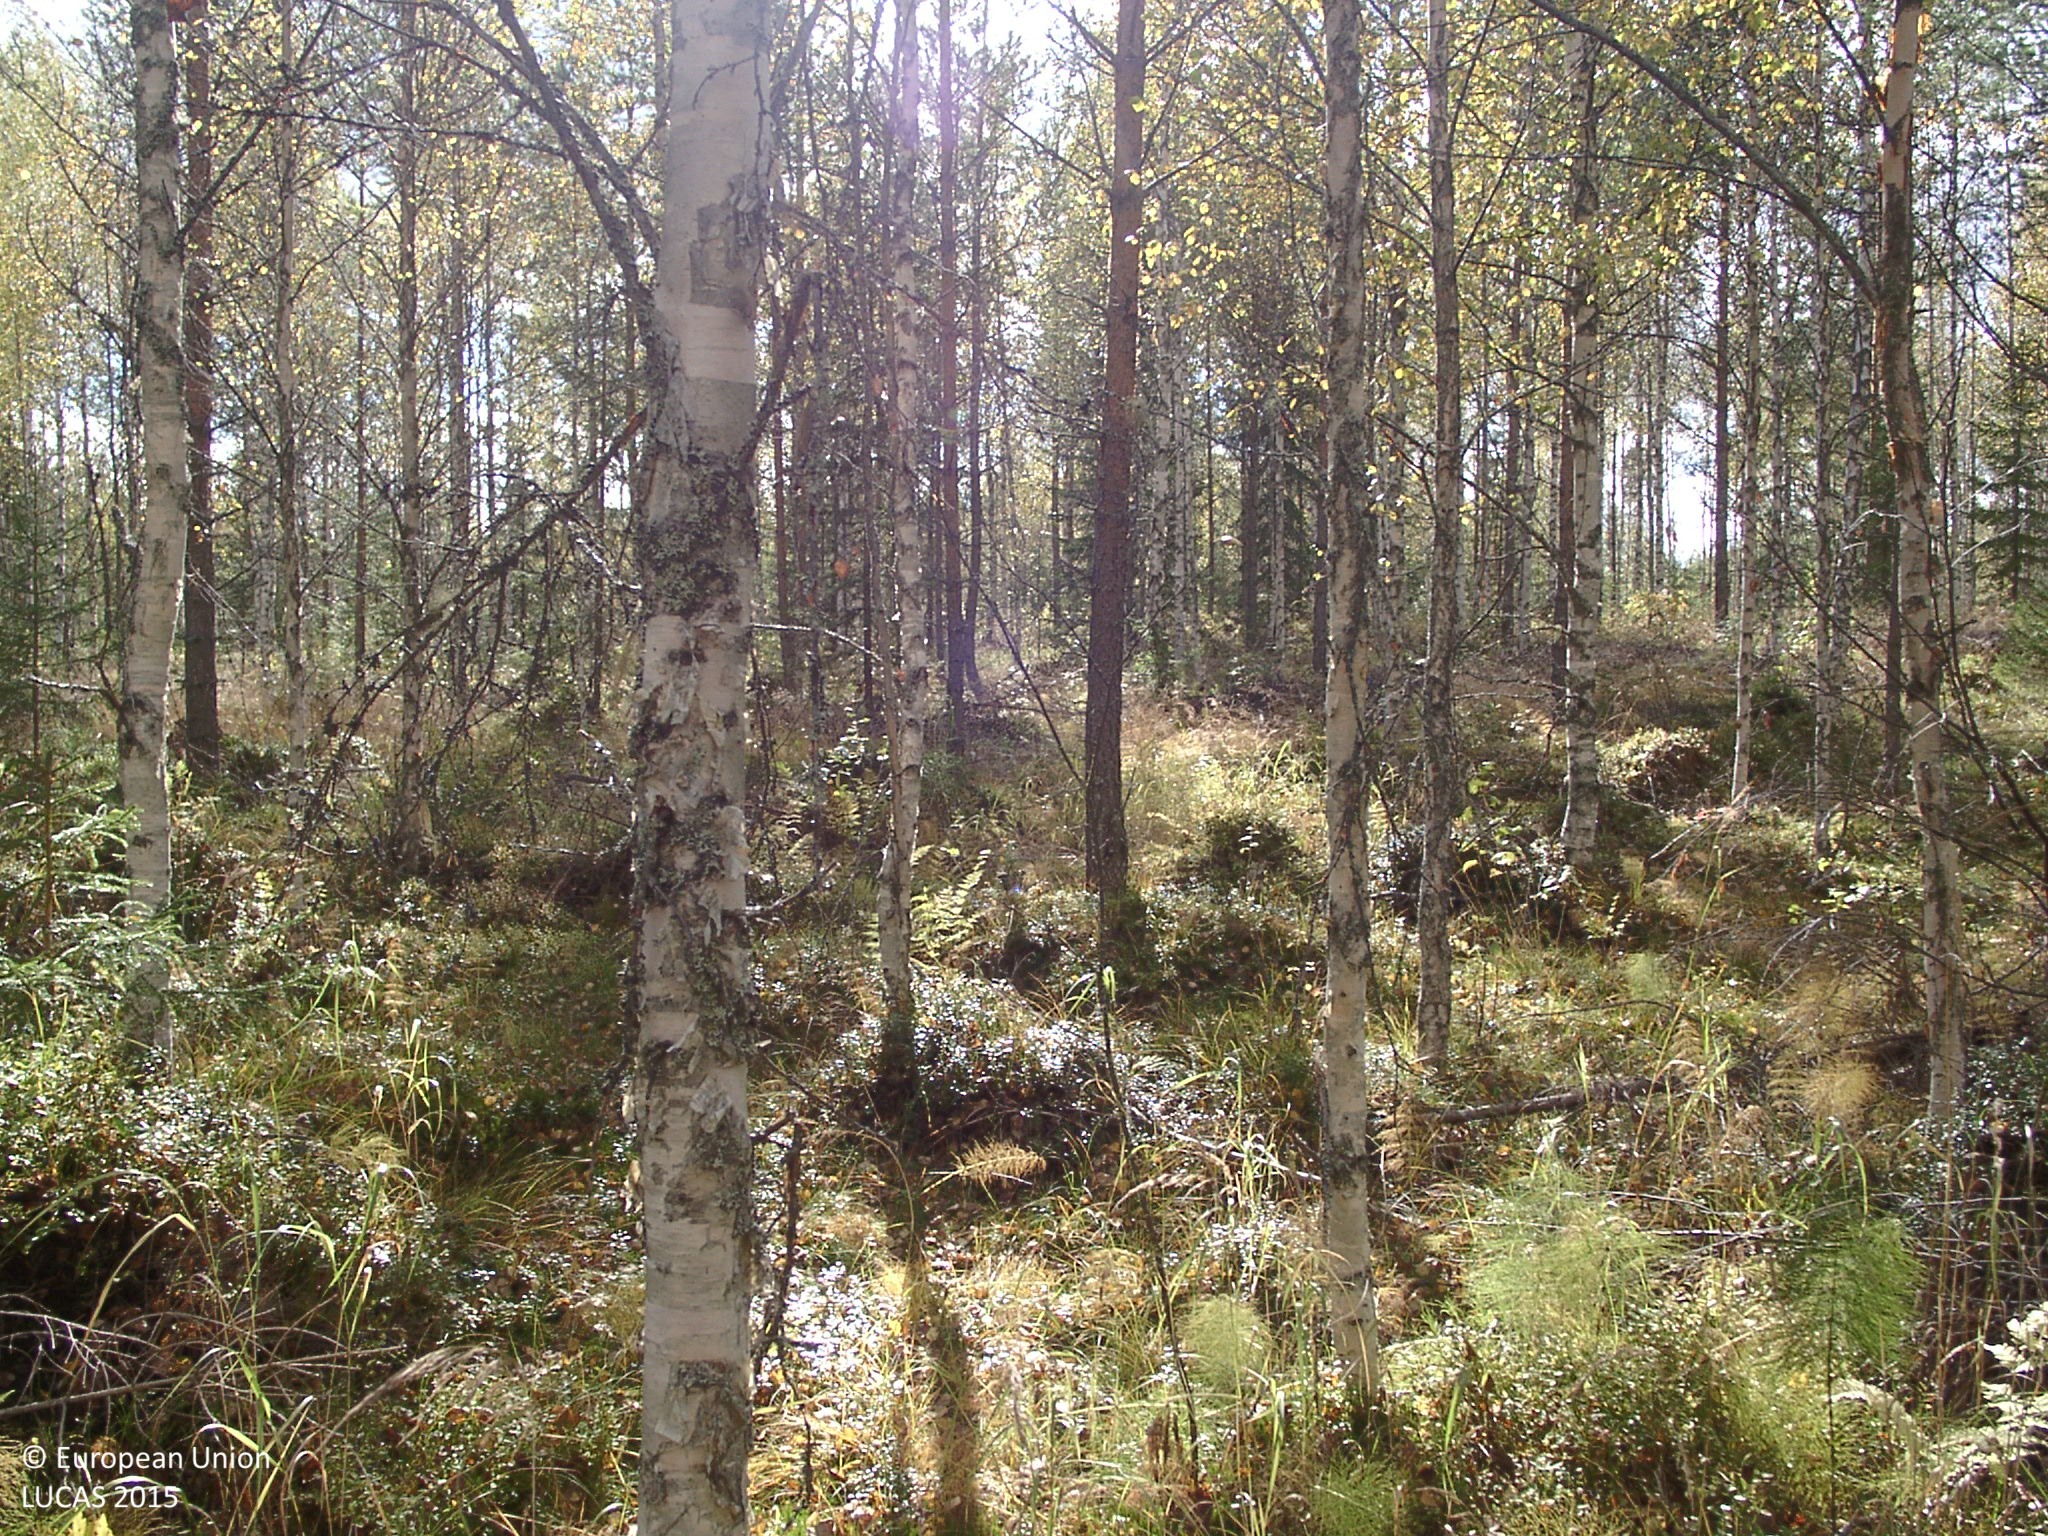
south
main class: Woodland
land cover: Pine dominated mixed woodland
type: boreal forest
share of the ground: 50 - 75 %
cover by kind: broadleaved forest trees 45 %, herbaceous plants 25 %, coniferous forest trees 15 %, lichens and mosses 10 %, shrubs 5 %
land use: Forestry
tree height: > 5 m
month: September
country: FI
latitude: 62.5182
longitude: 25.3564
